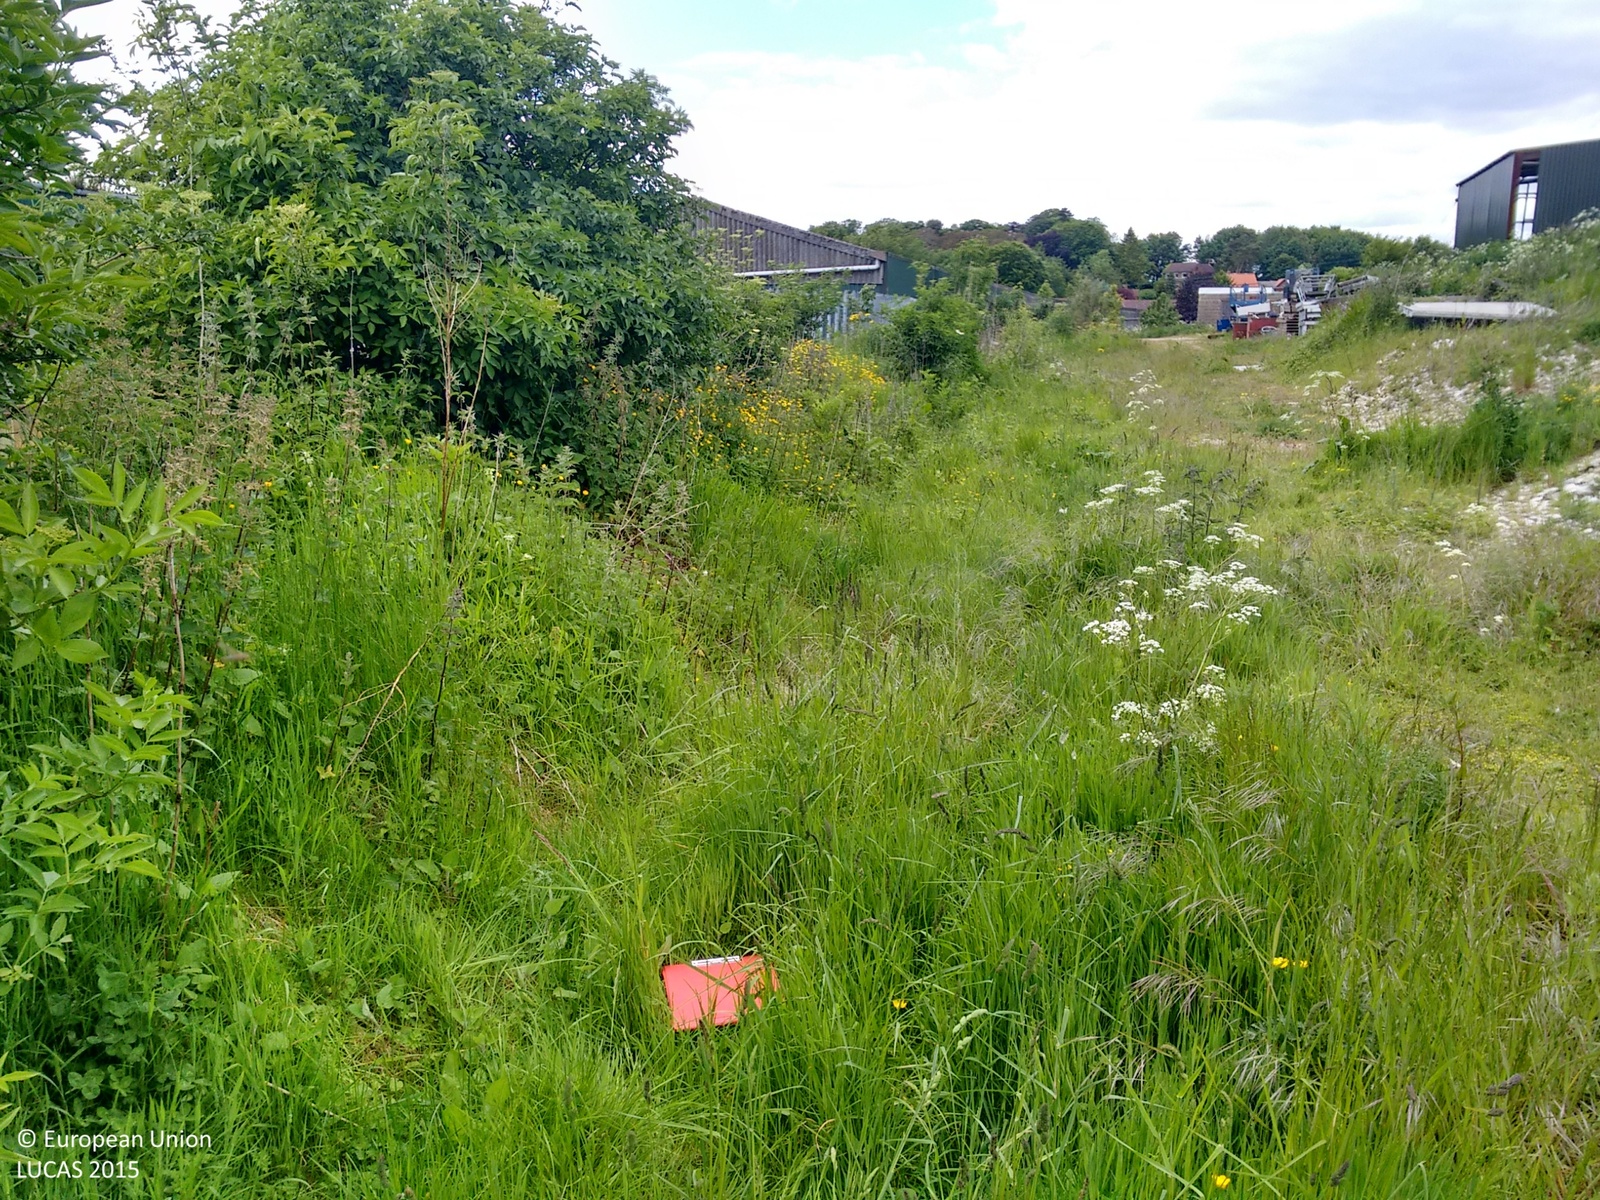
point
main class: Grassland
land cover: Spontaneously vegetated surfaces
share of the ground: > 75 %
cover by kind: herbaceous plants 100 %
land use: Agriculture (excluding fallow land and kitchen gardens)
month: June
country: GB
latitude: 53.4976
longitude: -0.1788
